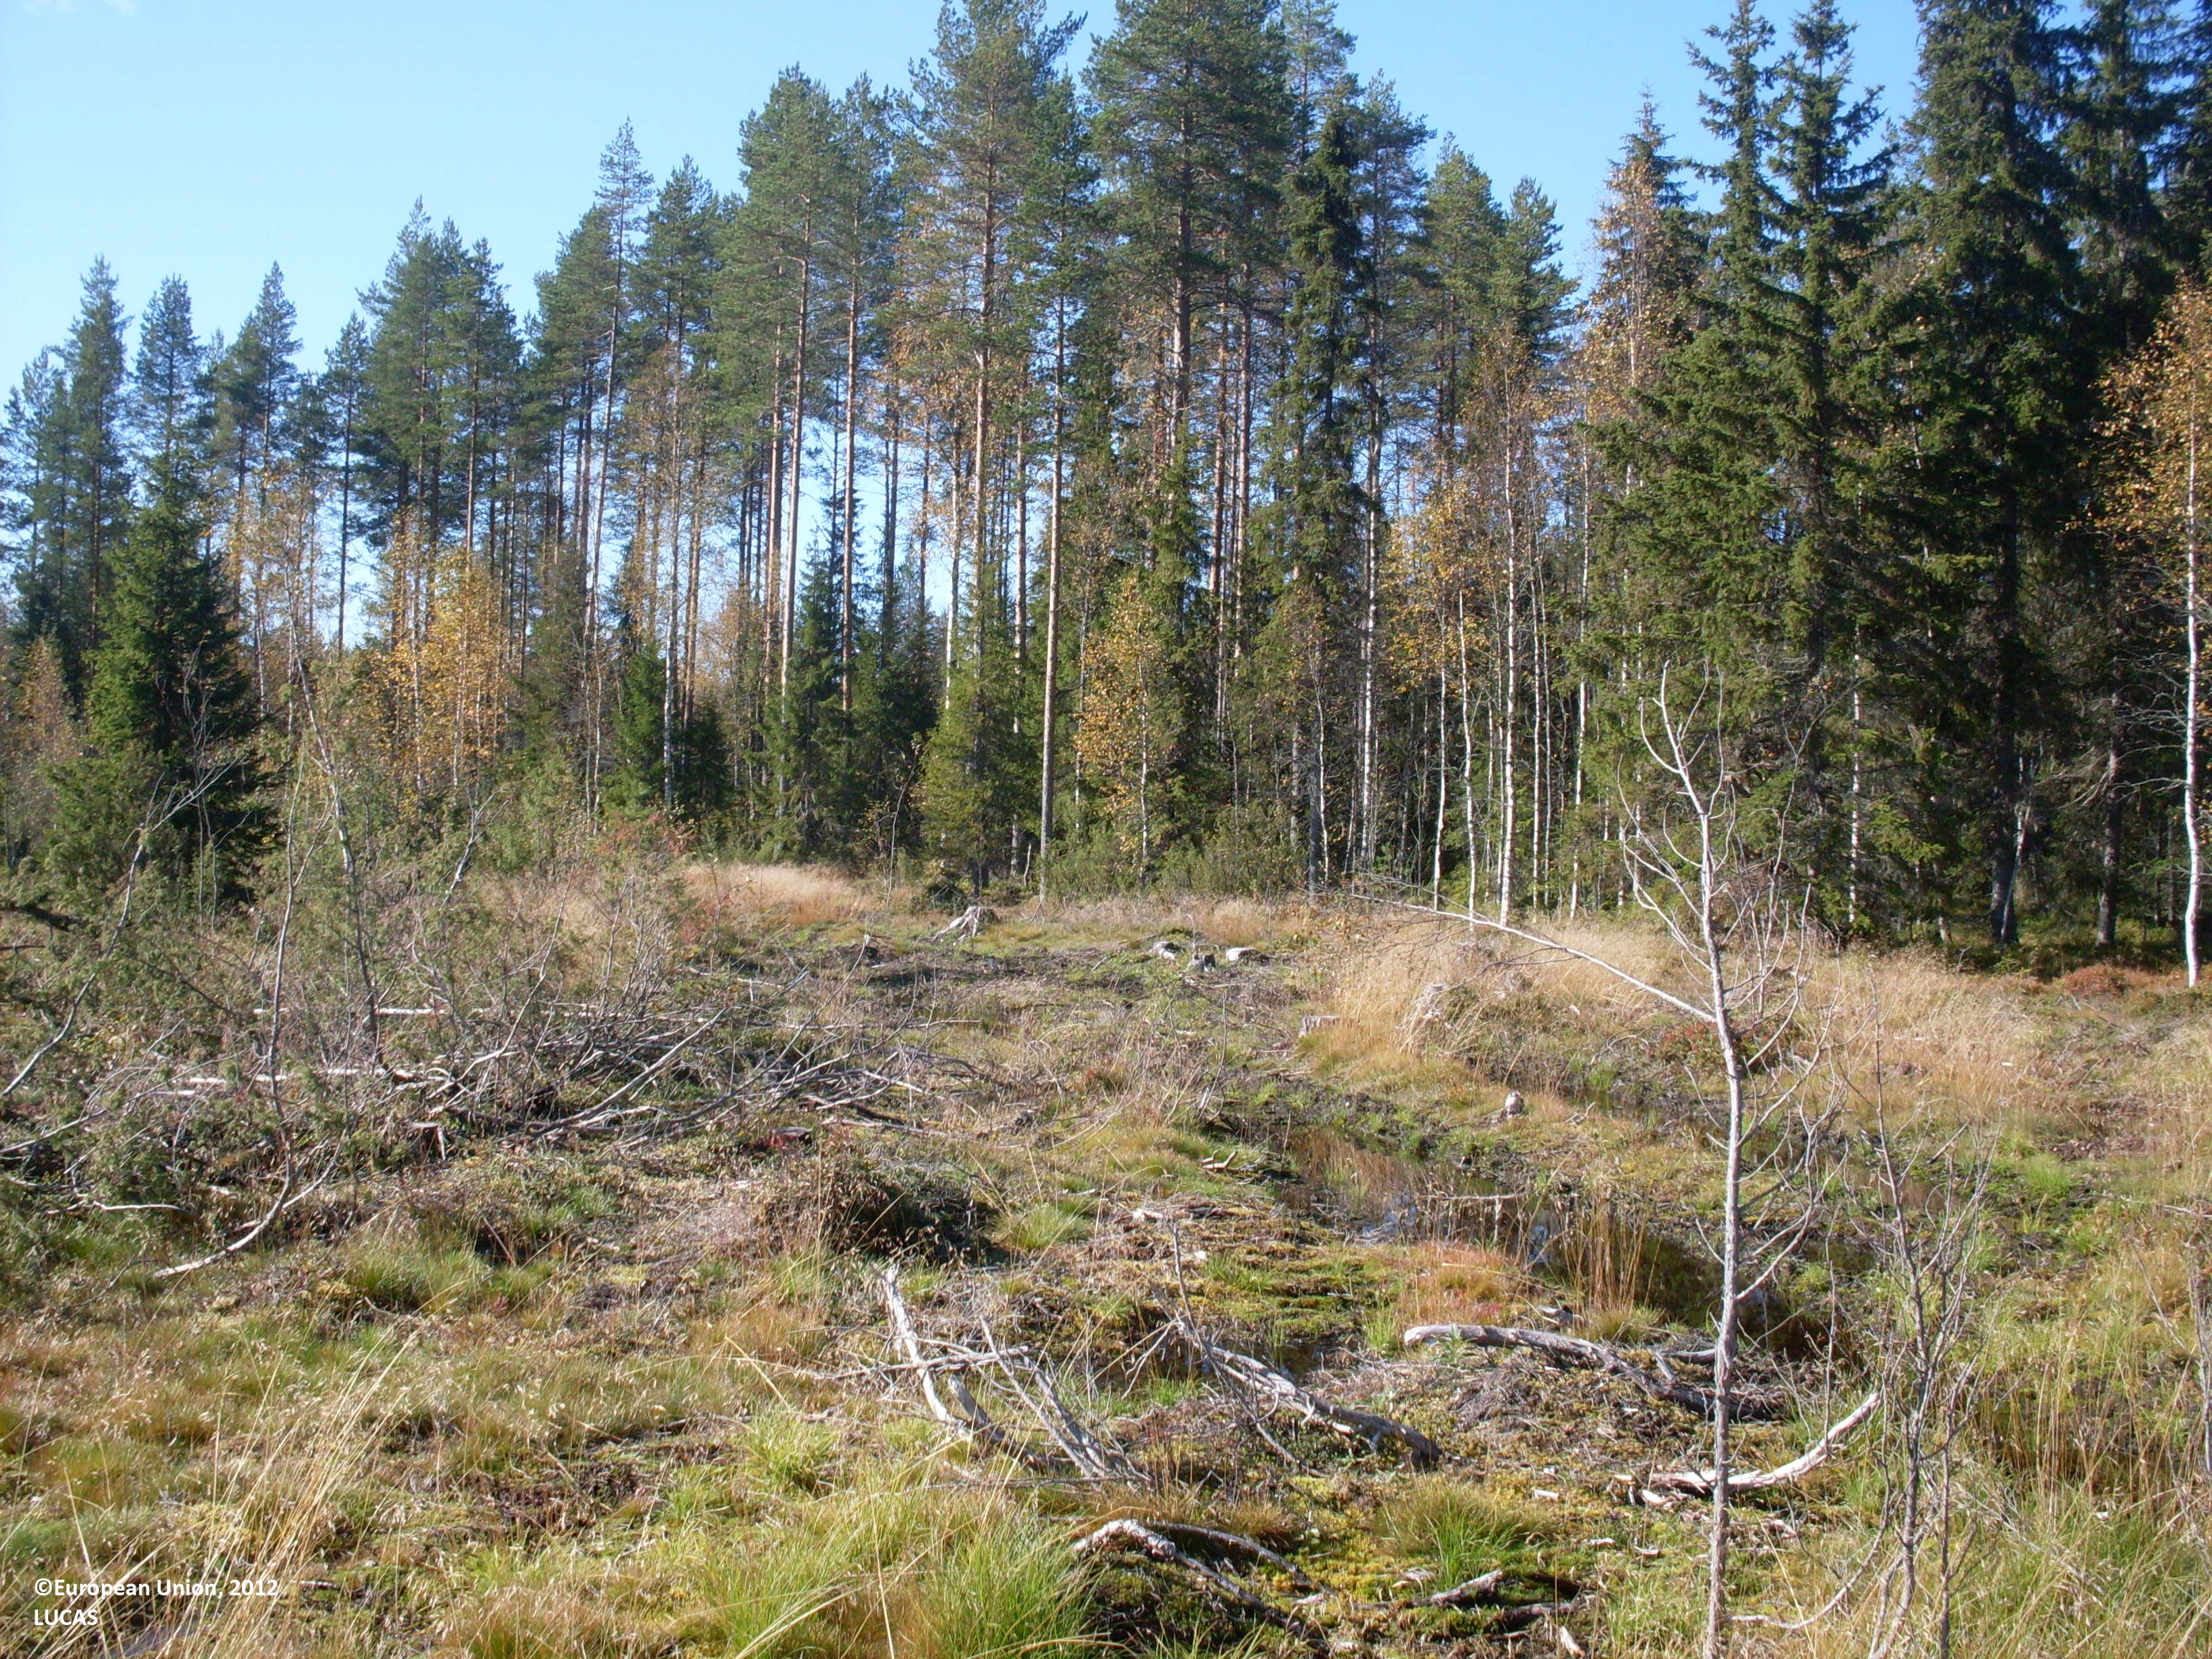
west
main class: Woodland
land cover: Pine dominated mixed woodland
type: boreal forest
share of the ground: 50 - 75 %
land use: Forestry
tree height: > 5 m
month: September
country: FI
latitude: 64.3059
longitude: 28.4725
